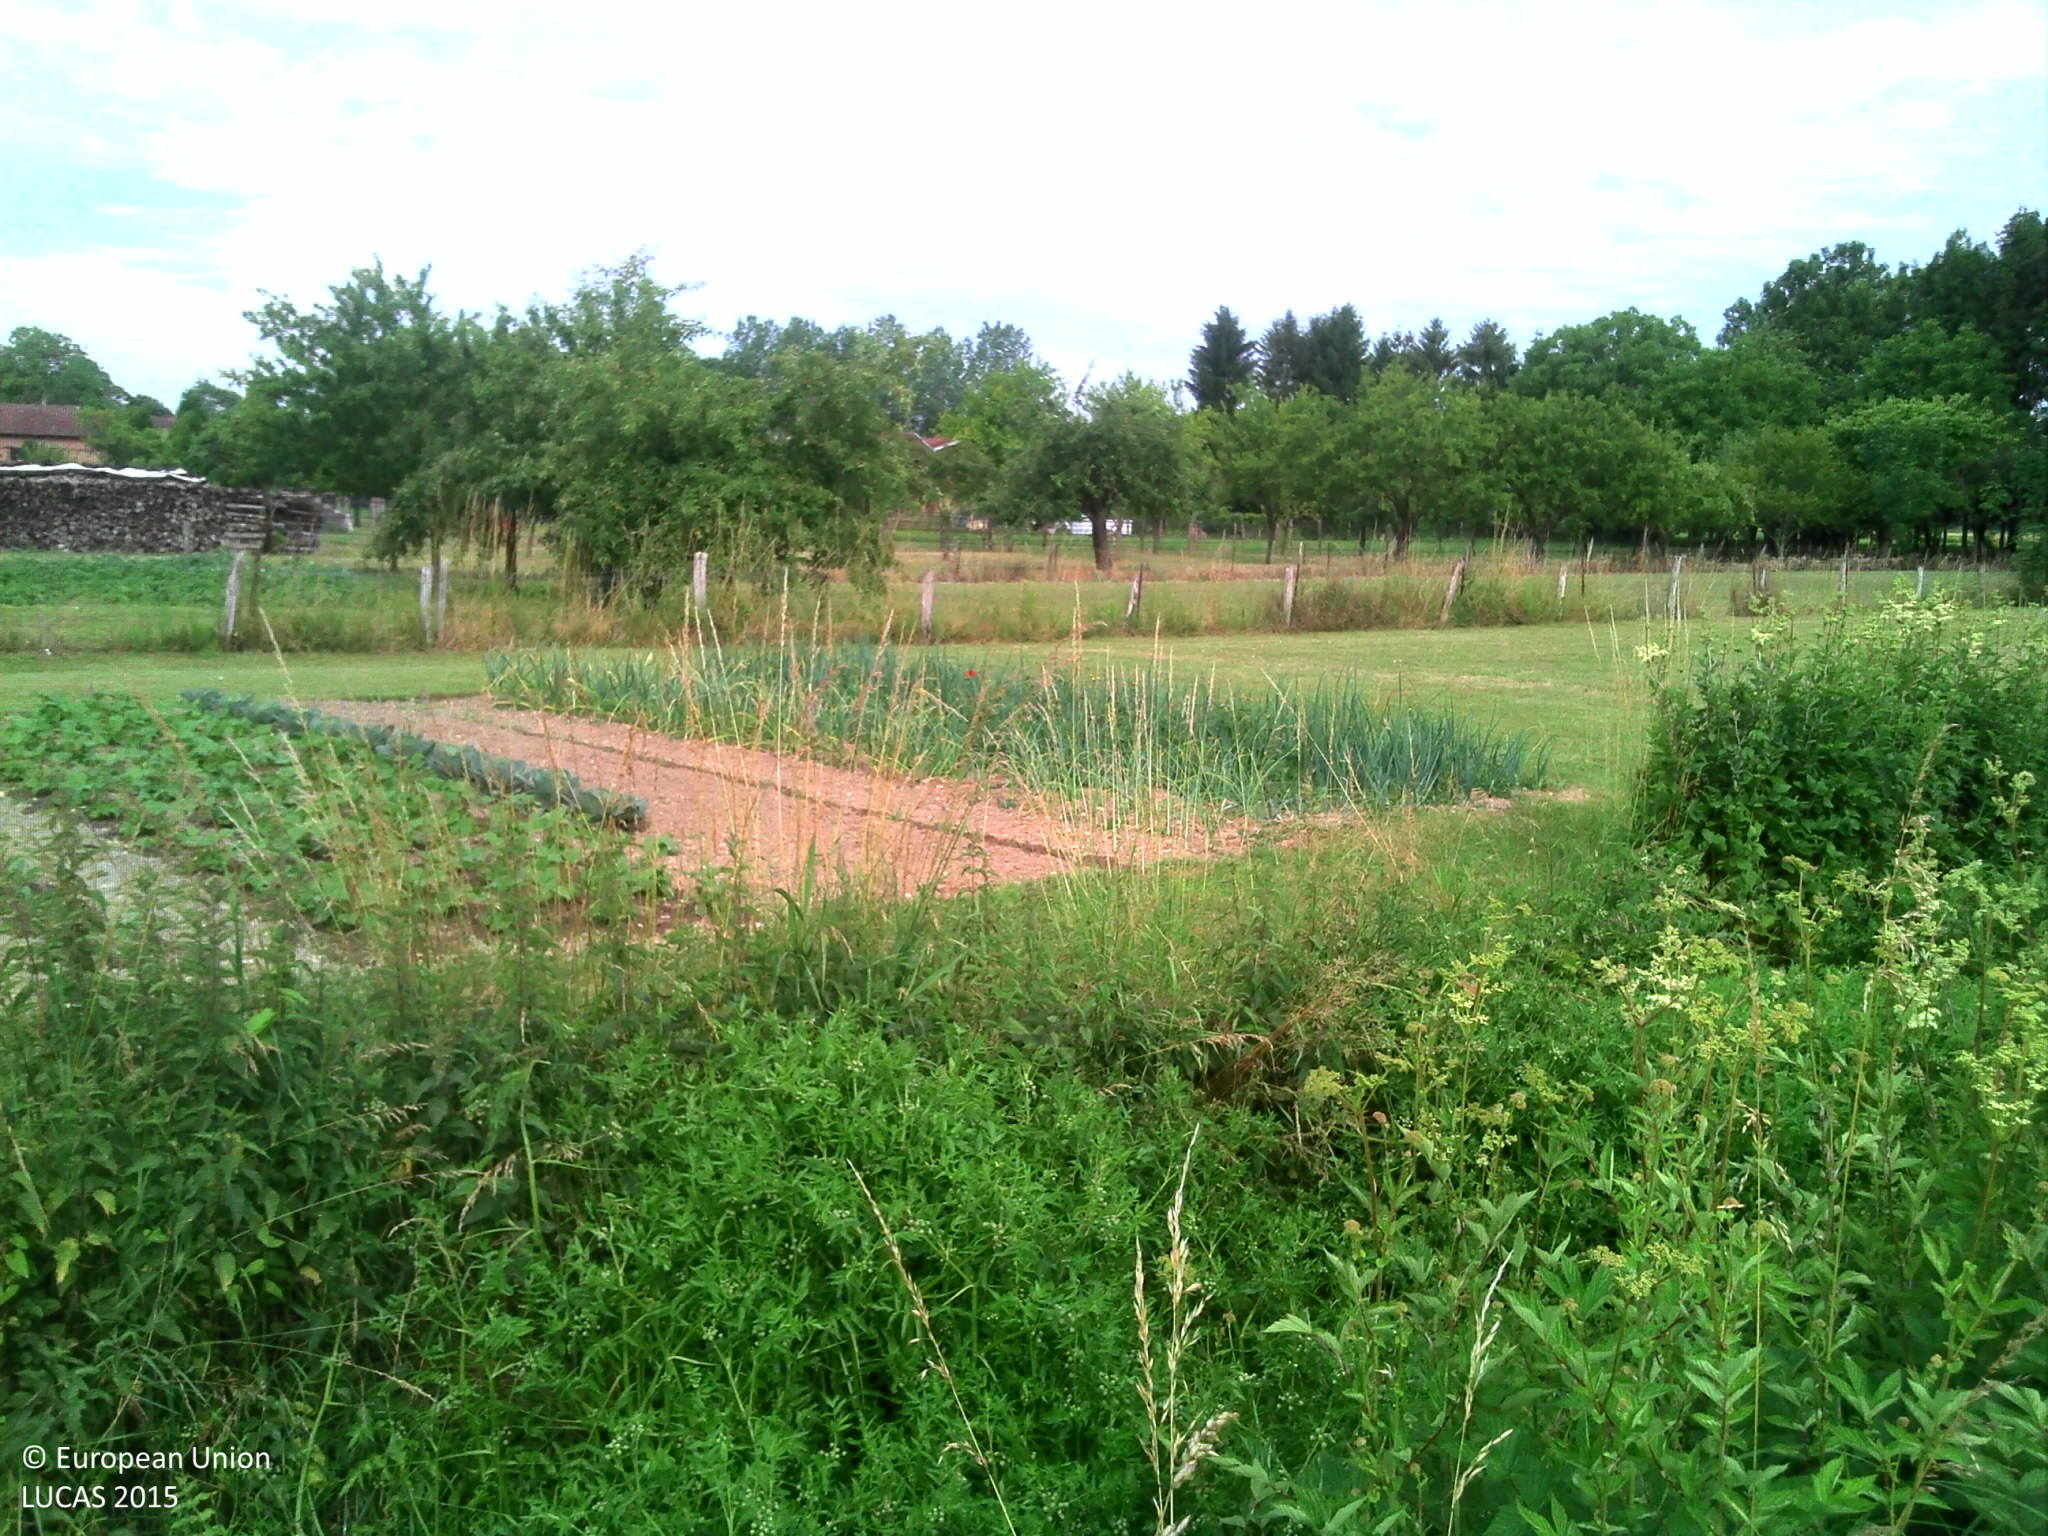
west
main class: Grassland
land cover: Grassland without tree/shrub cover
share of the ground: > 75 %
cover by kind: herbaceous plants 100 %
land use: Agriculture (excluding fallow land and kitchen gardens)
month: June
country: FR
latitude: 48.8274
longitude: 4.9169
